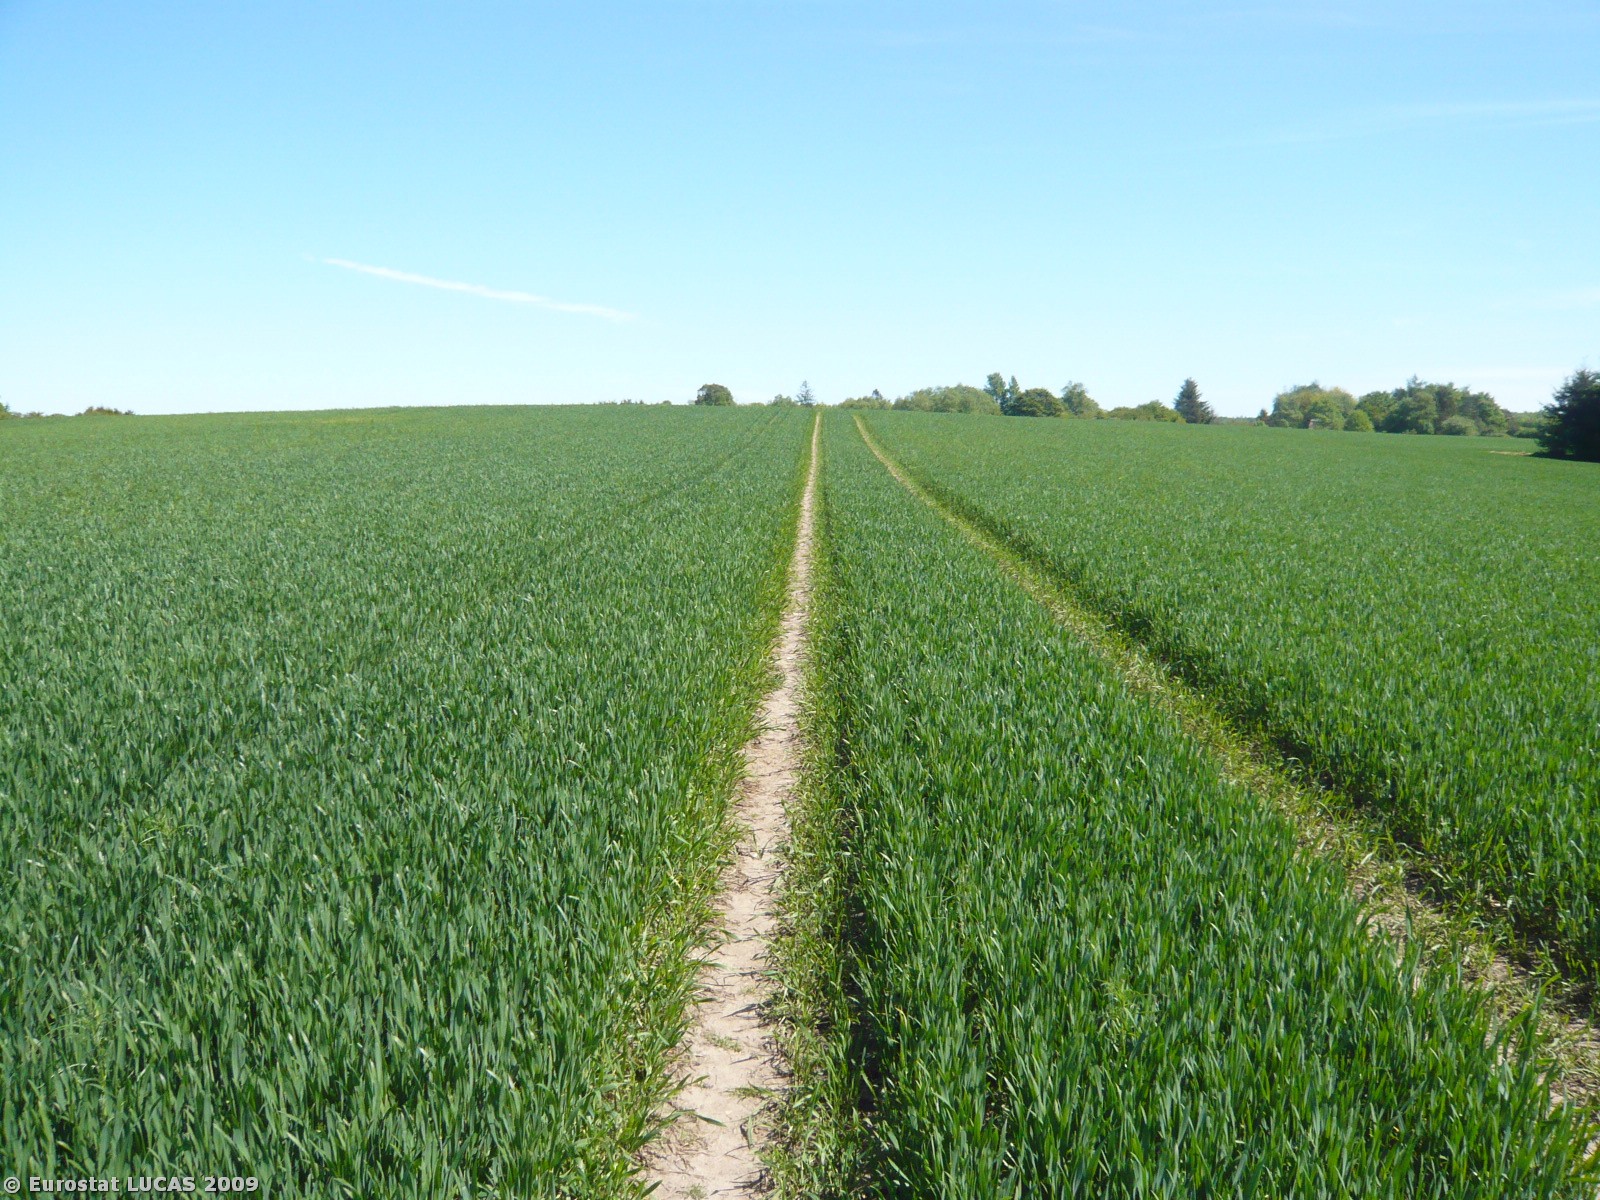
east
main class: Cropland
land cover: Common wheat
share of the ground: > 75 %
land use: Agriculture (excluding fallow land and kitchen gardens)
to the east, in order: Common wheat
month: May
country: DK
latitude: 55.2383
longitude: 11.9329
